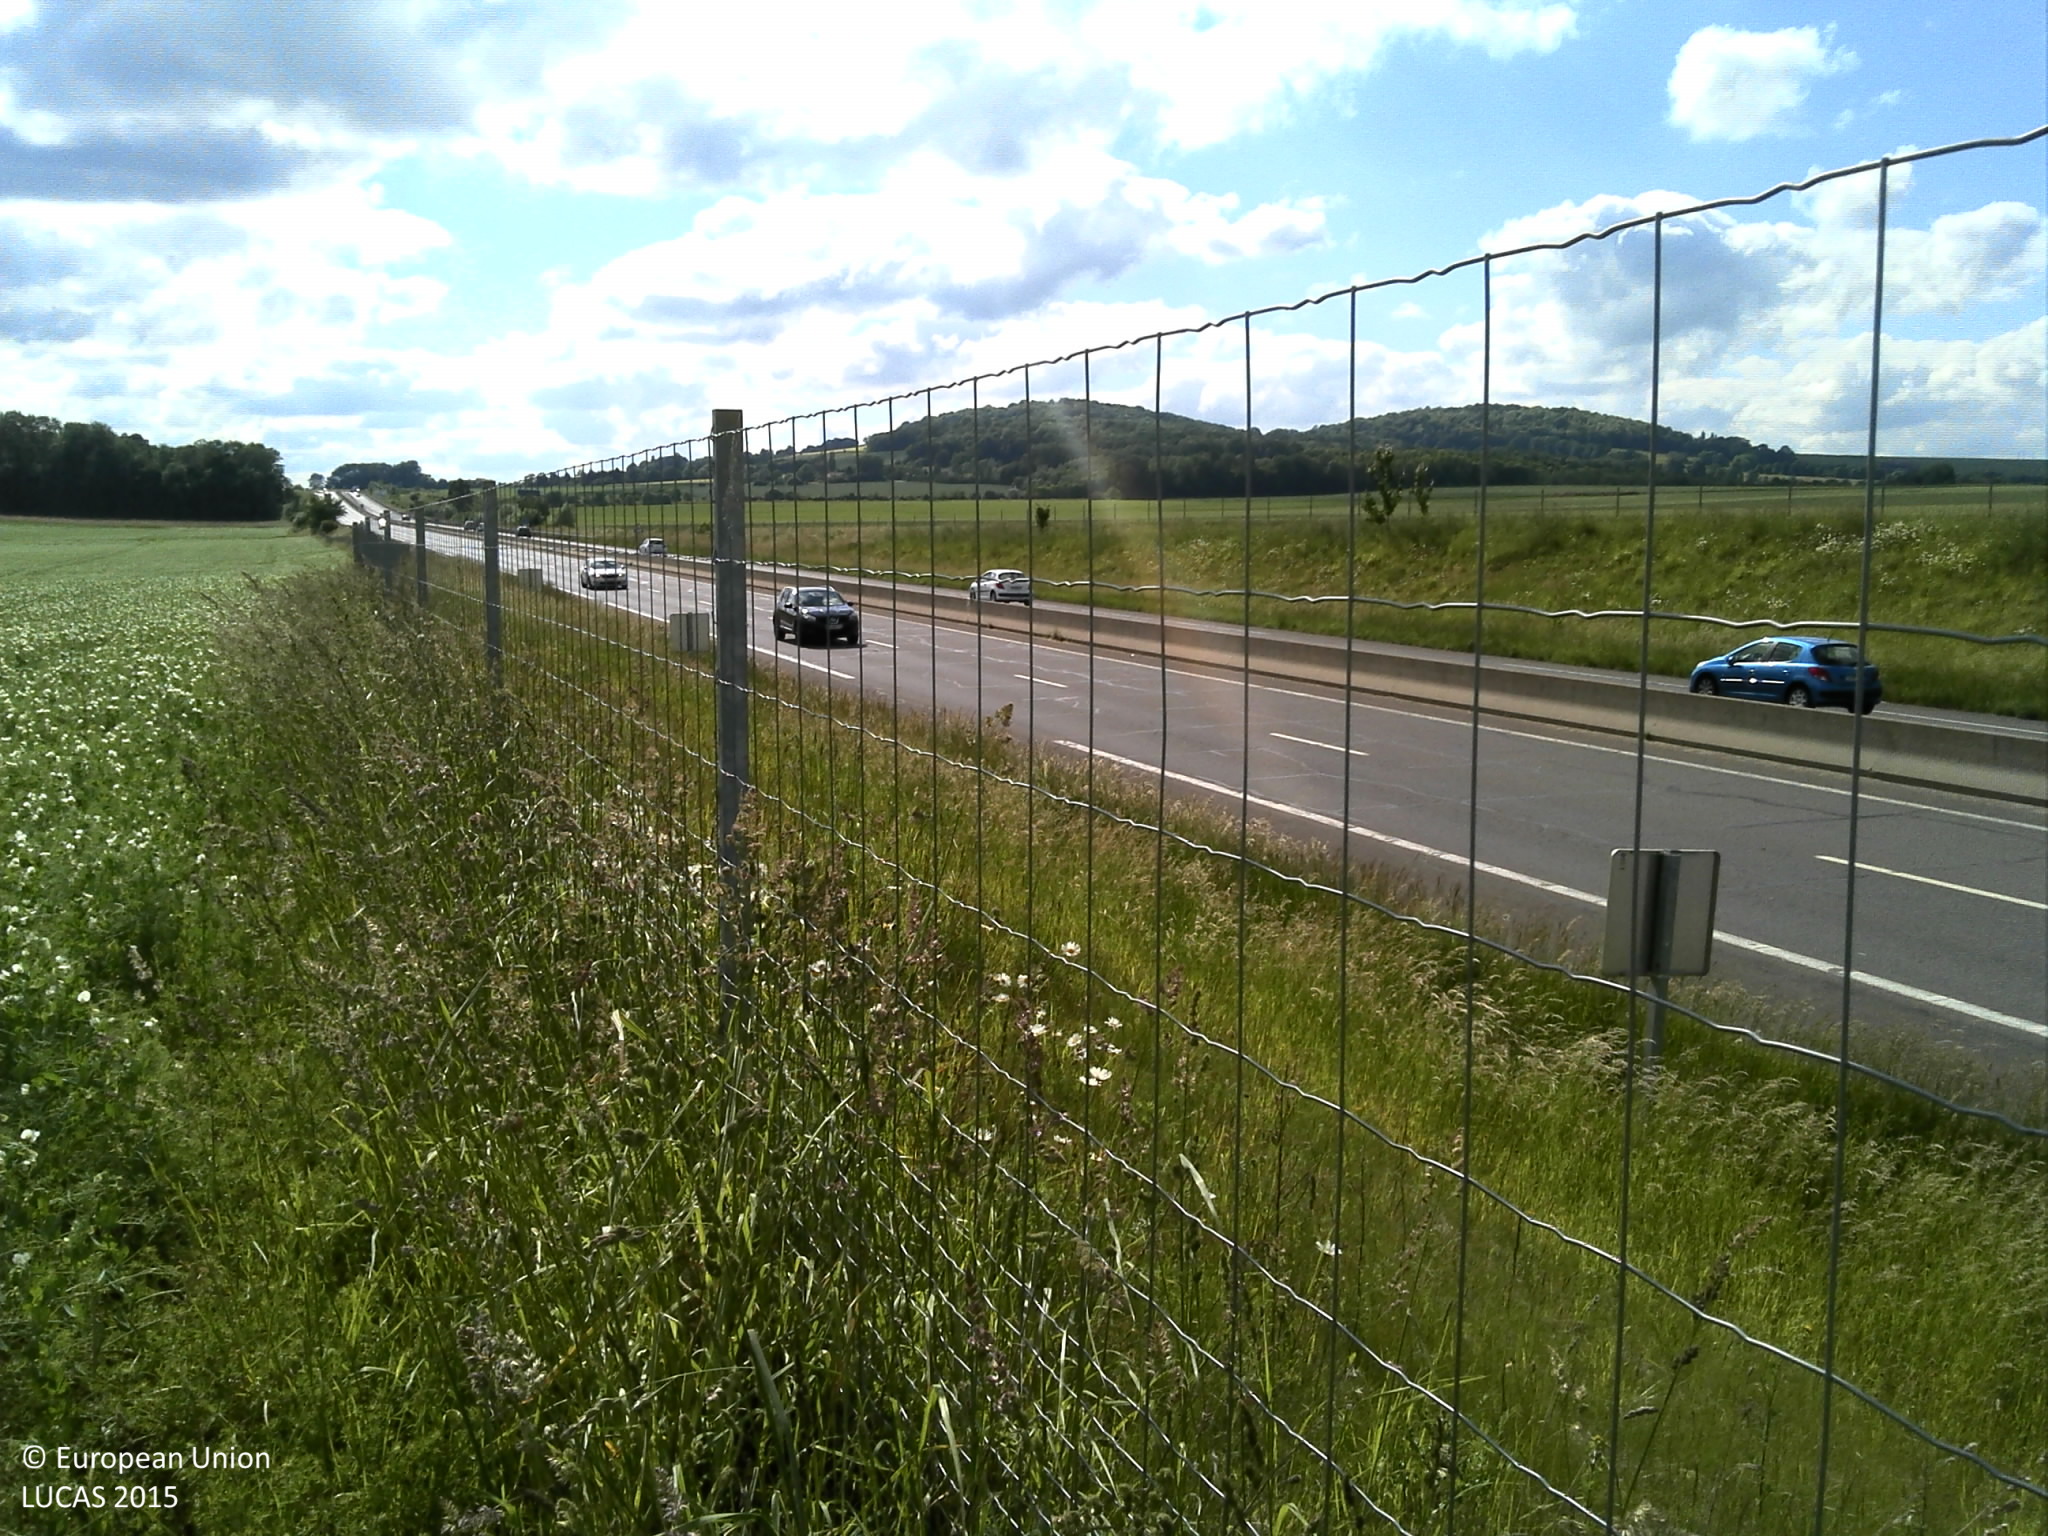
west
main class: Grassland
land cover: Grassland without tree/shrub cover
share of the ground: > 75 %
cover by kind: herbaceous plants 100 %
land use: Semi-natural and natural areas not in use
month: June
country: FR
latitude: 49.0382
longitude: 6.1285
